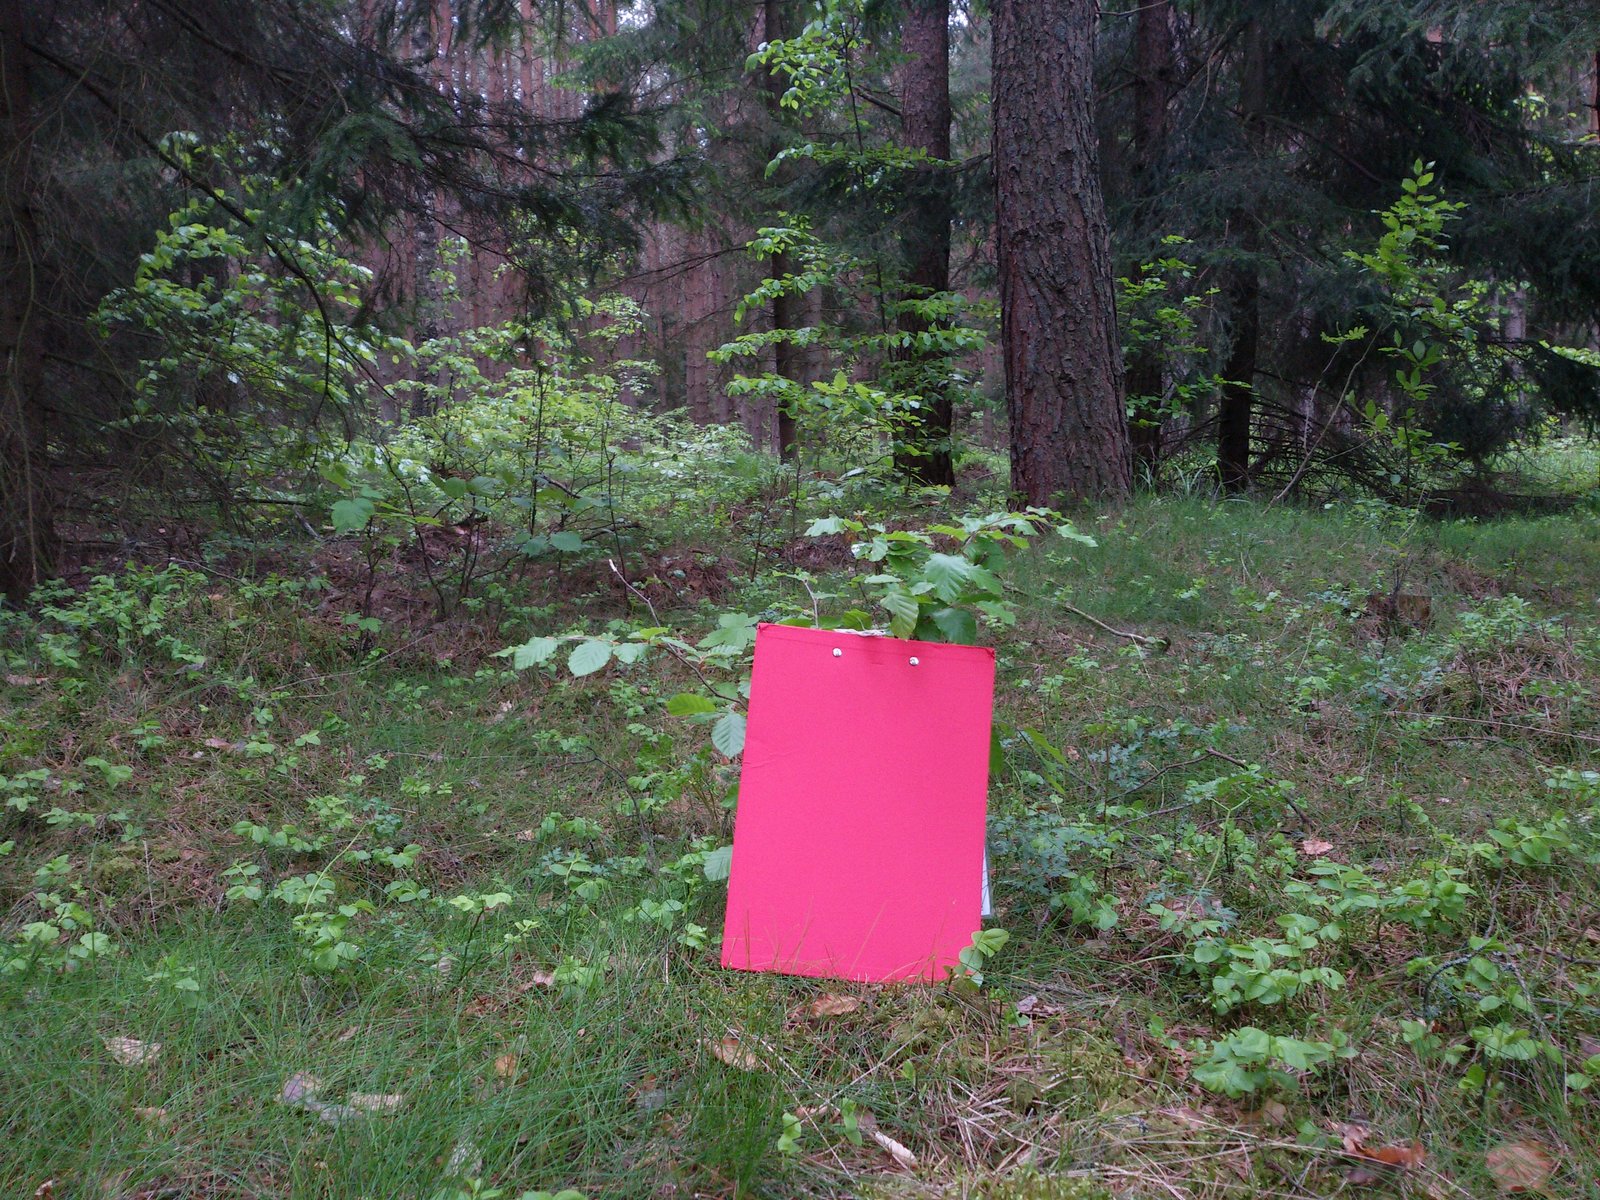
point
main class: Woodland
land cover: Pine dominated coniferous woodland
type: hemiboreal forest and nemoral coniferous forest and mixed broadleaved-coniferous forest
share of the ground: > 75 %
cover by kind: coniferous forest trees 80 %, shrubs 10 %, herbaceous plants 10 %
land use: Forestry
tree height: > 5 m
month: May
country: PL
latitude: 53.5661
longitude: 21.0511
